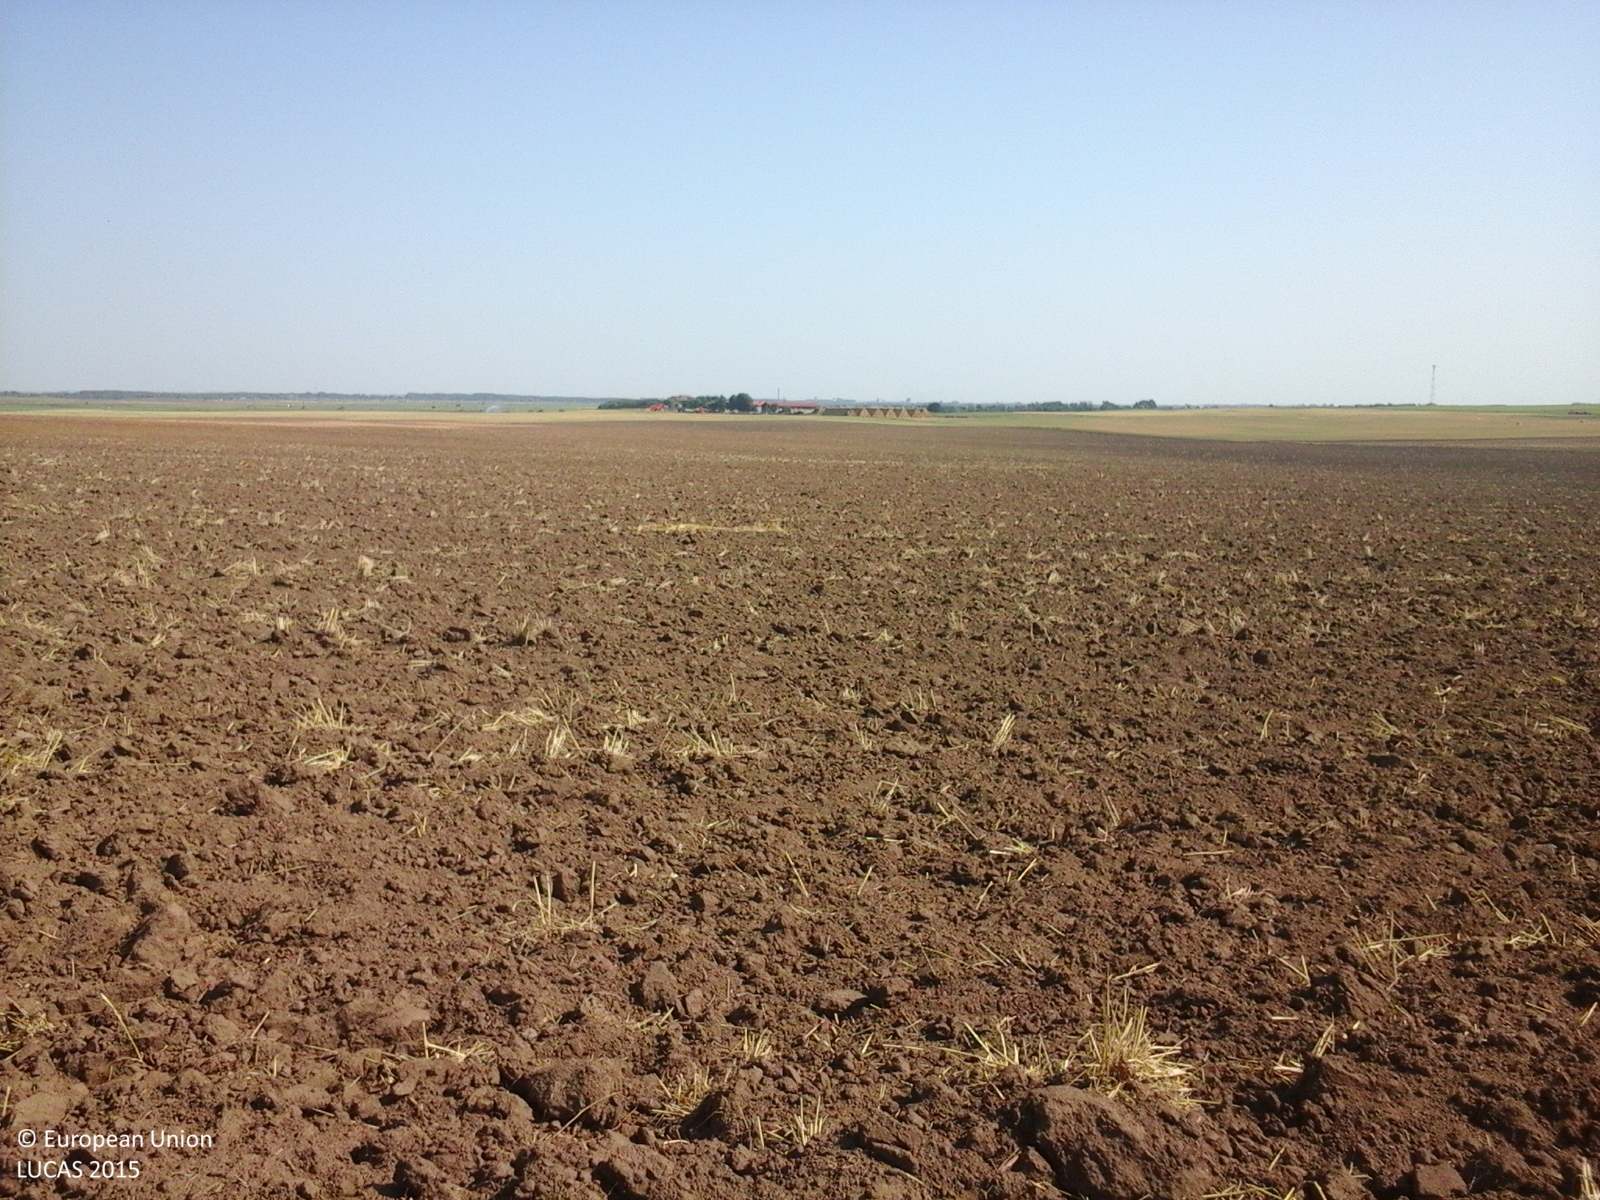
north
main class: Cropland
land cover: Common wheat
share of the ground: < 10 %
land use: Agriculture (excluding fallow land and kitchen gardens)
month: July
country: RO
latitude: 44.5795
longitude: 27.6152
